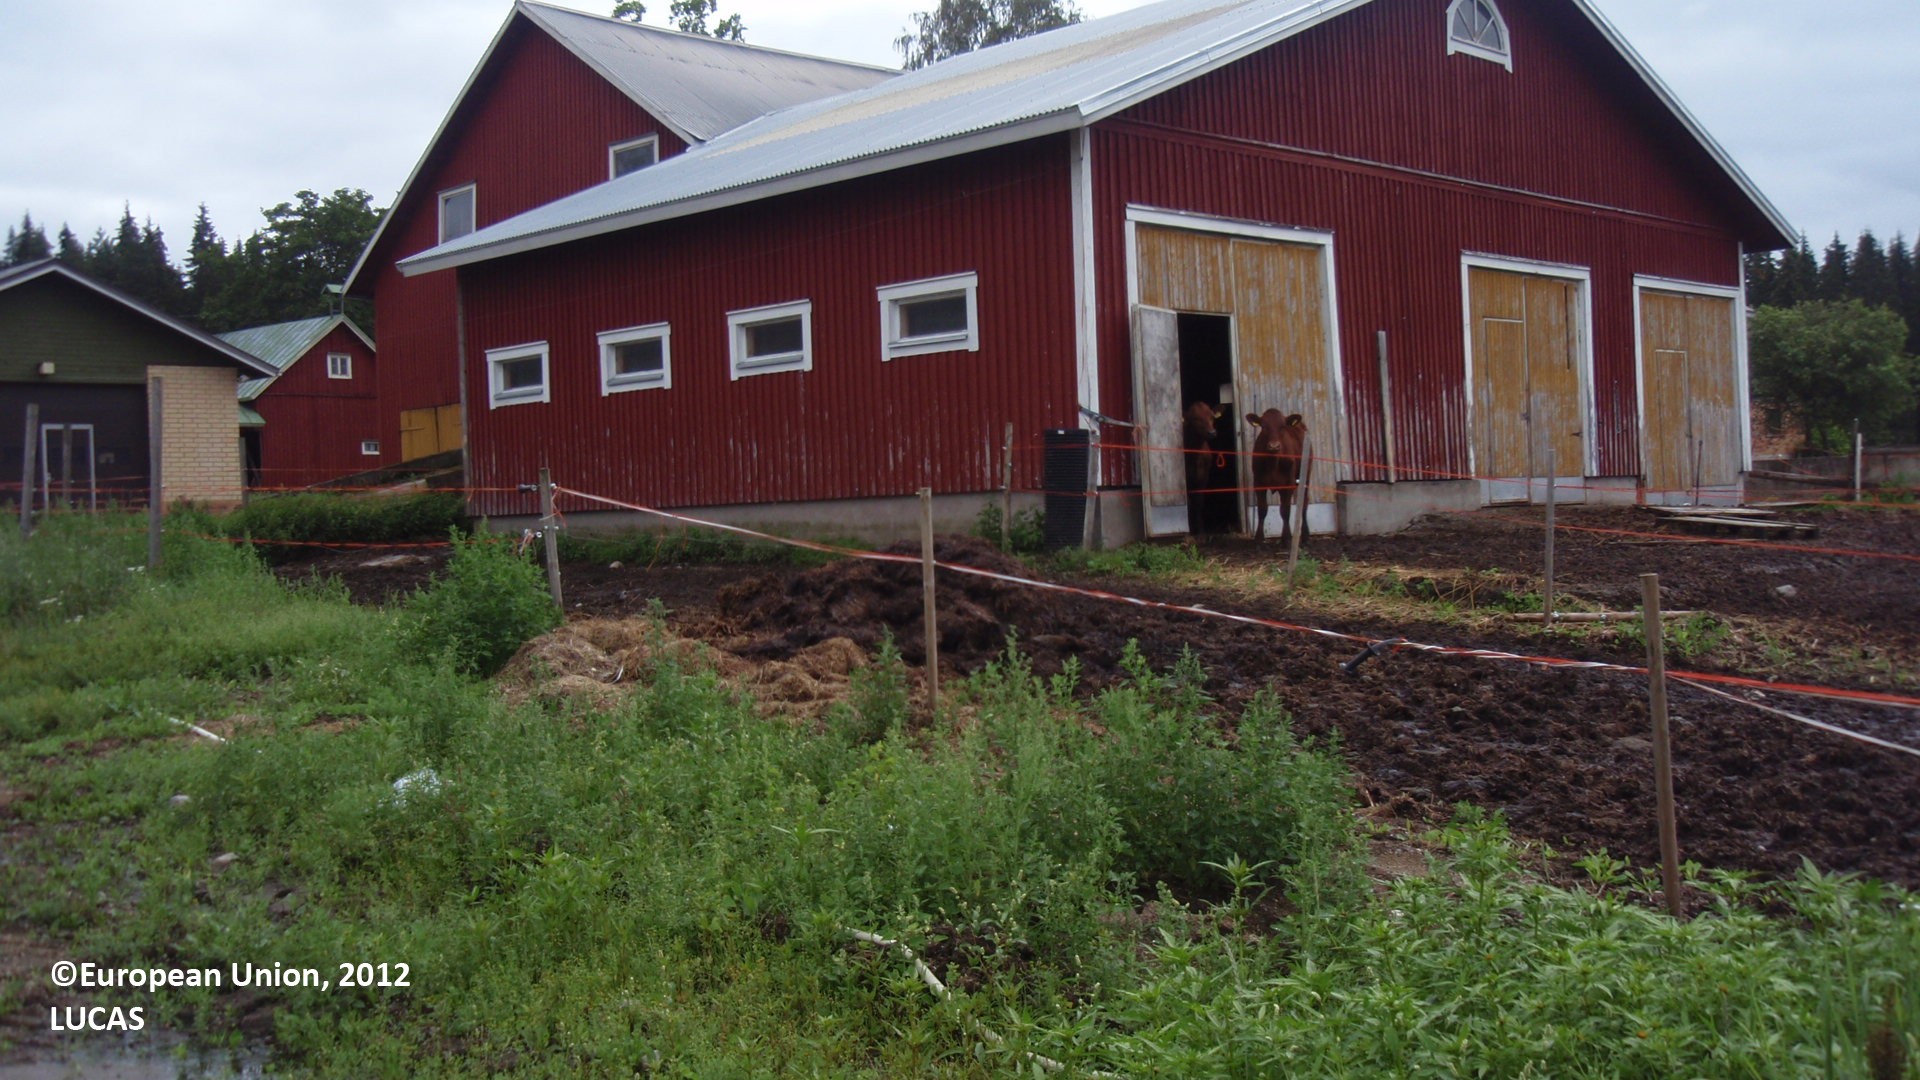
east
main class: Grassland
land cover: Grassland without tree/shrub cover
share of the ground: > 75 %
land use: Agriculture (excluding fallow land and kitchen gardens)
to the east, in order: Grassland without tree/shrub cover; Fences; Tracks; Grassland without tree/shrub cover; Artificial constructions in urban areas; Grassland without tree/shrub cover; Tracks; Ditches and canals; Fences; Grassland without tree/shrub cover; Grass margins; Fences; Grass margins; Lines of trees; Paved roads, cycling and walking lanes; Temporary grasslands
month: July
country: FI
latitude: 61.5329
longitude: 27.3815
